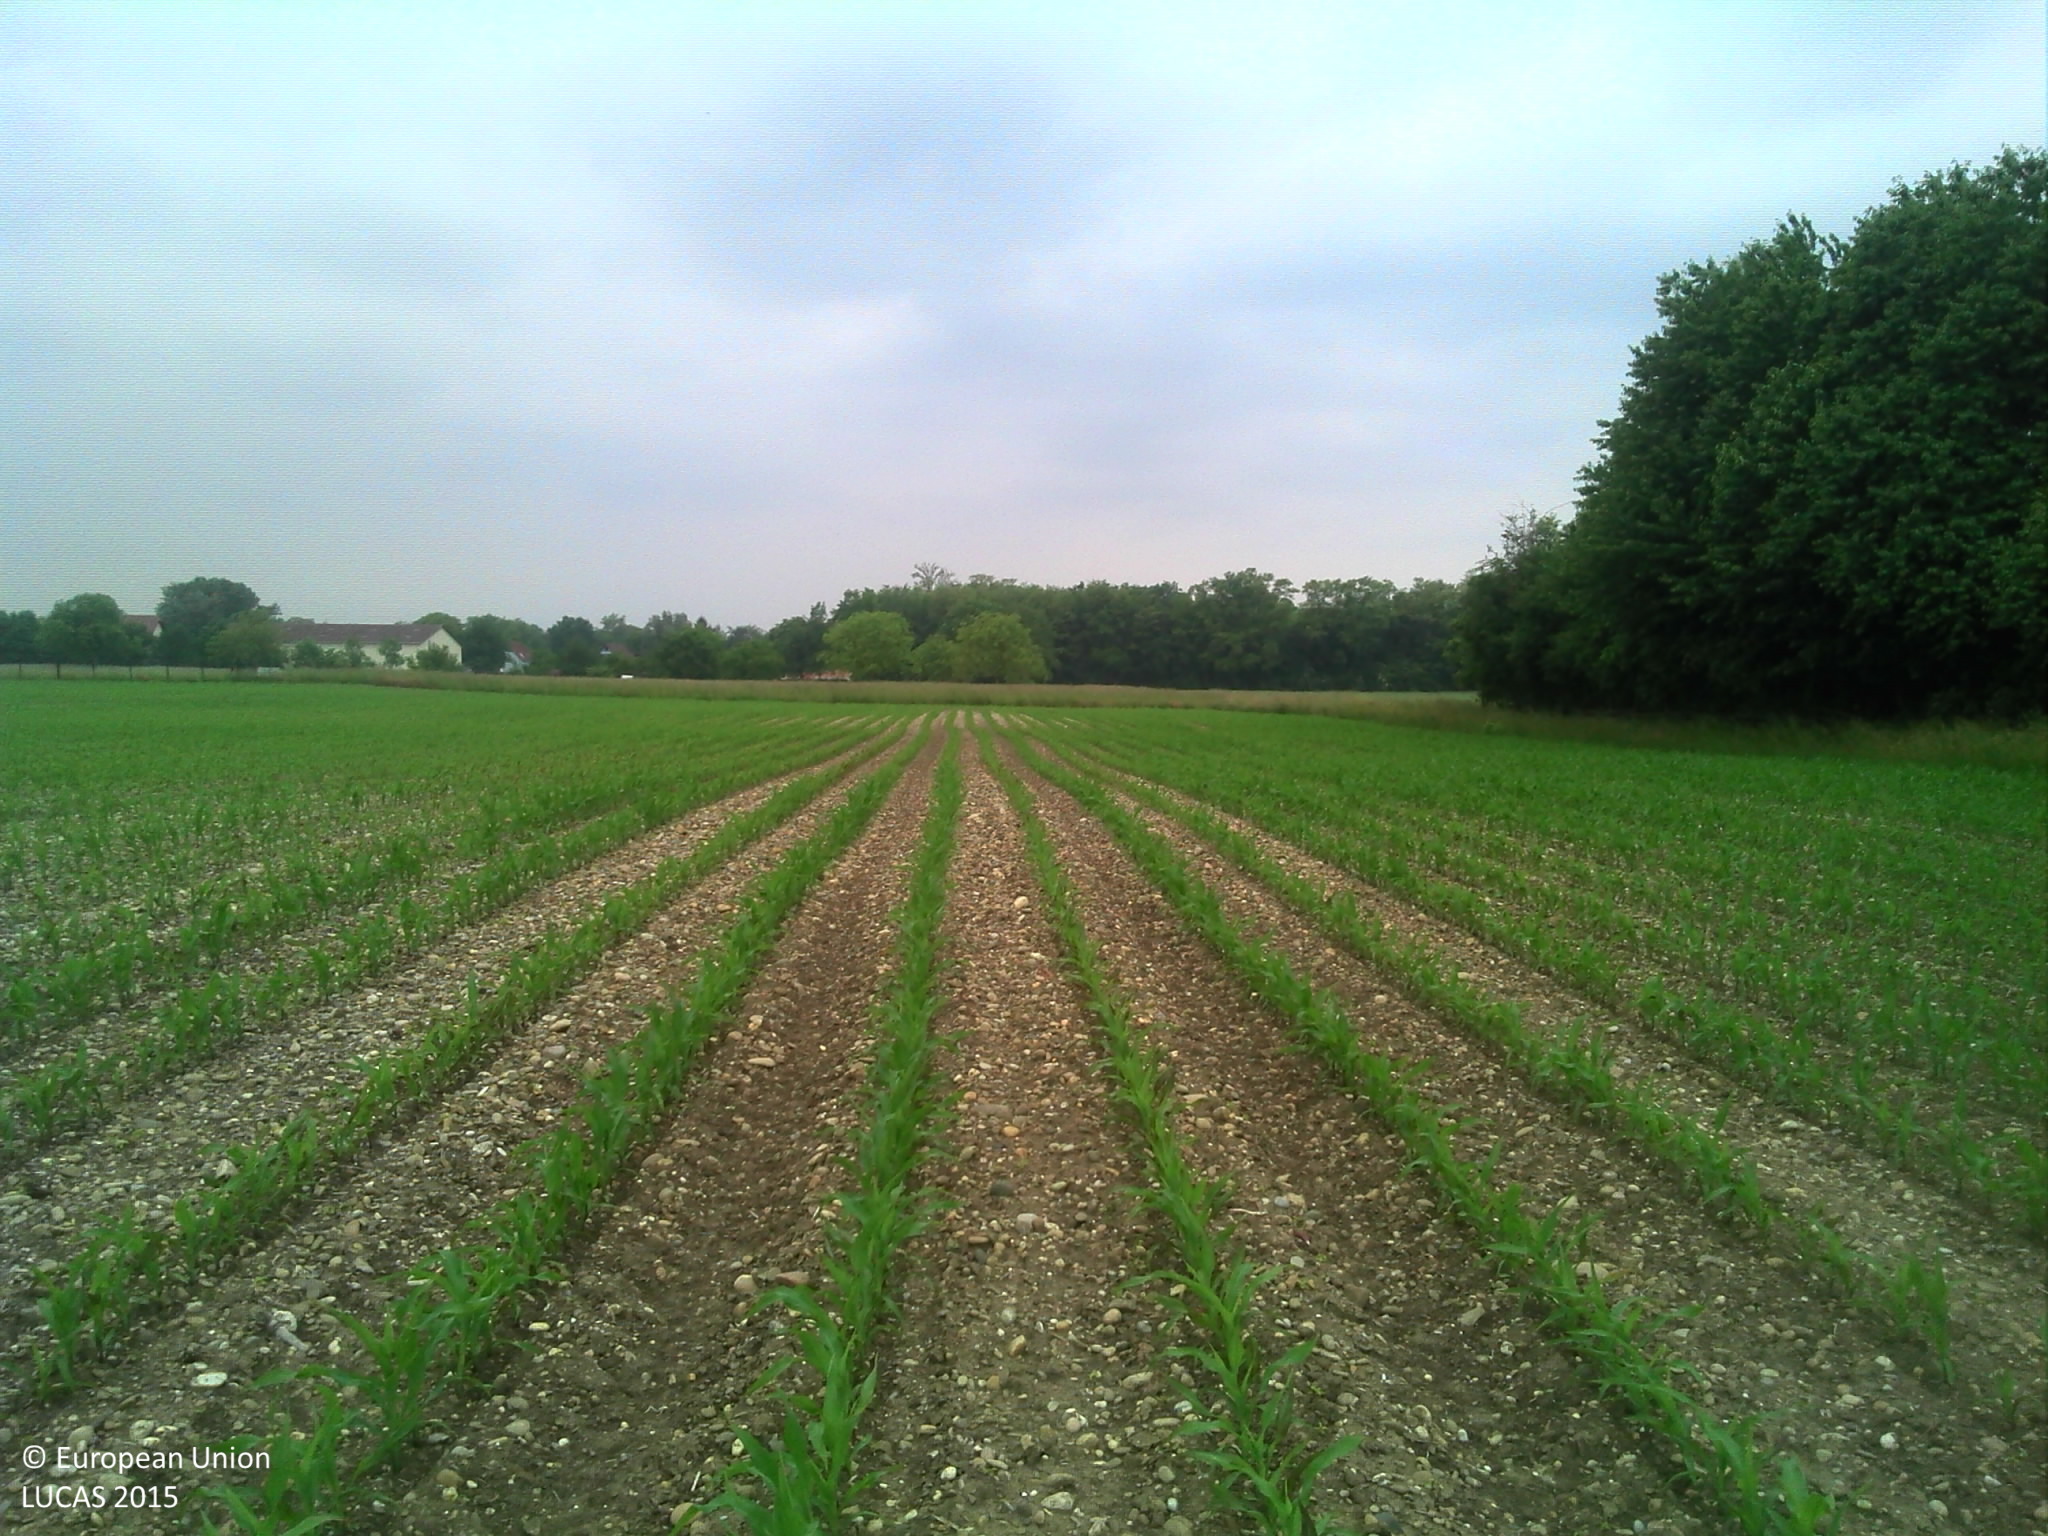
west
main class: Cropland
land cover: Maize
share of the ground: > 75 %
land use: Agriculture (excluding fallow land and kitchen gardens)
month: May
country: FR
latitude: 48.2692
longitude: 7.5894
